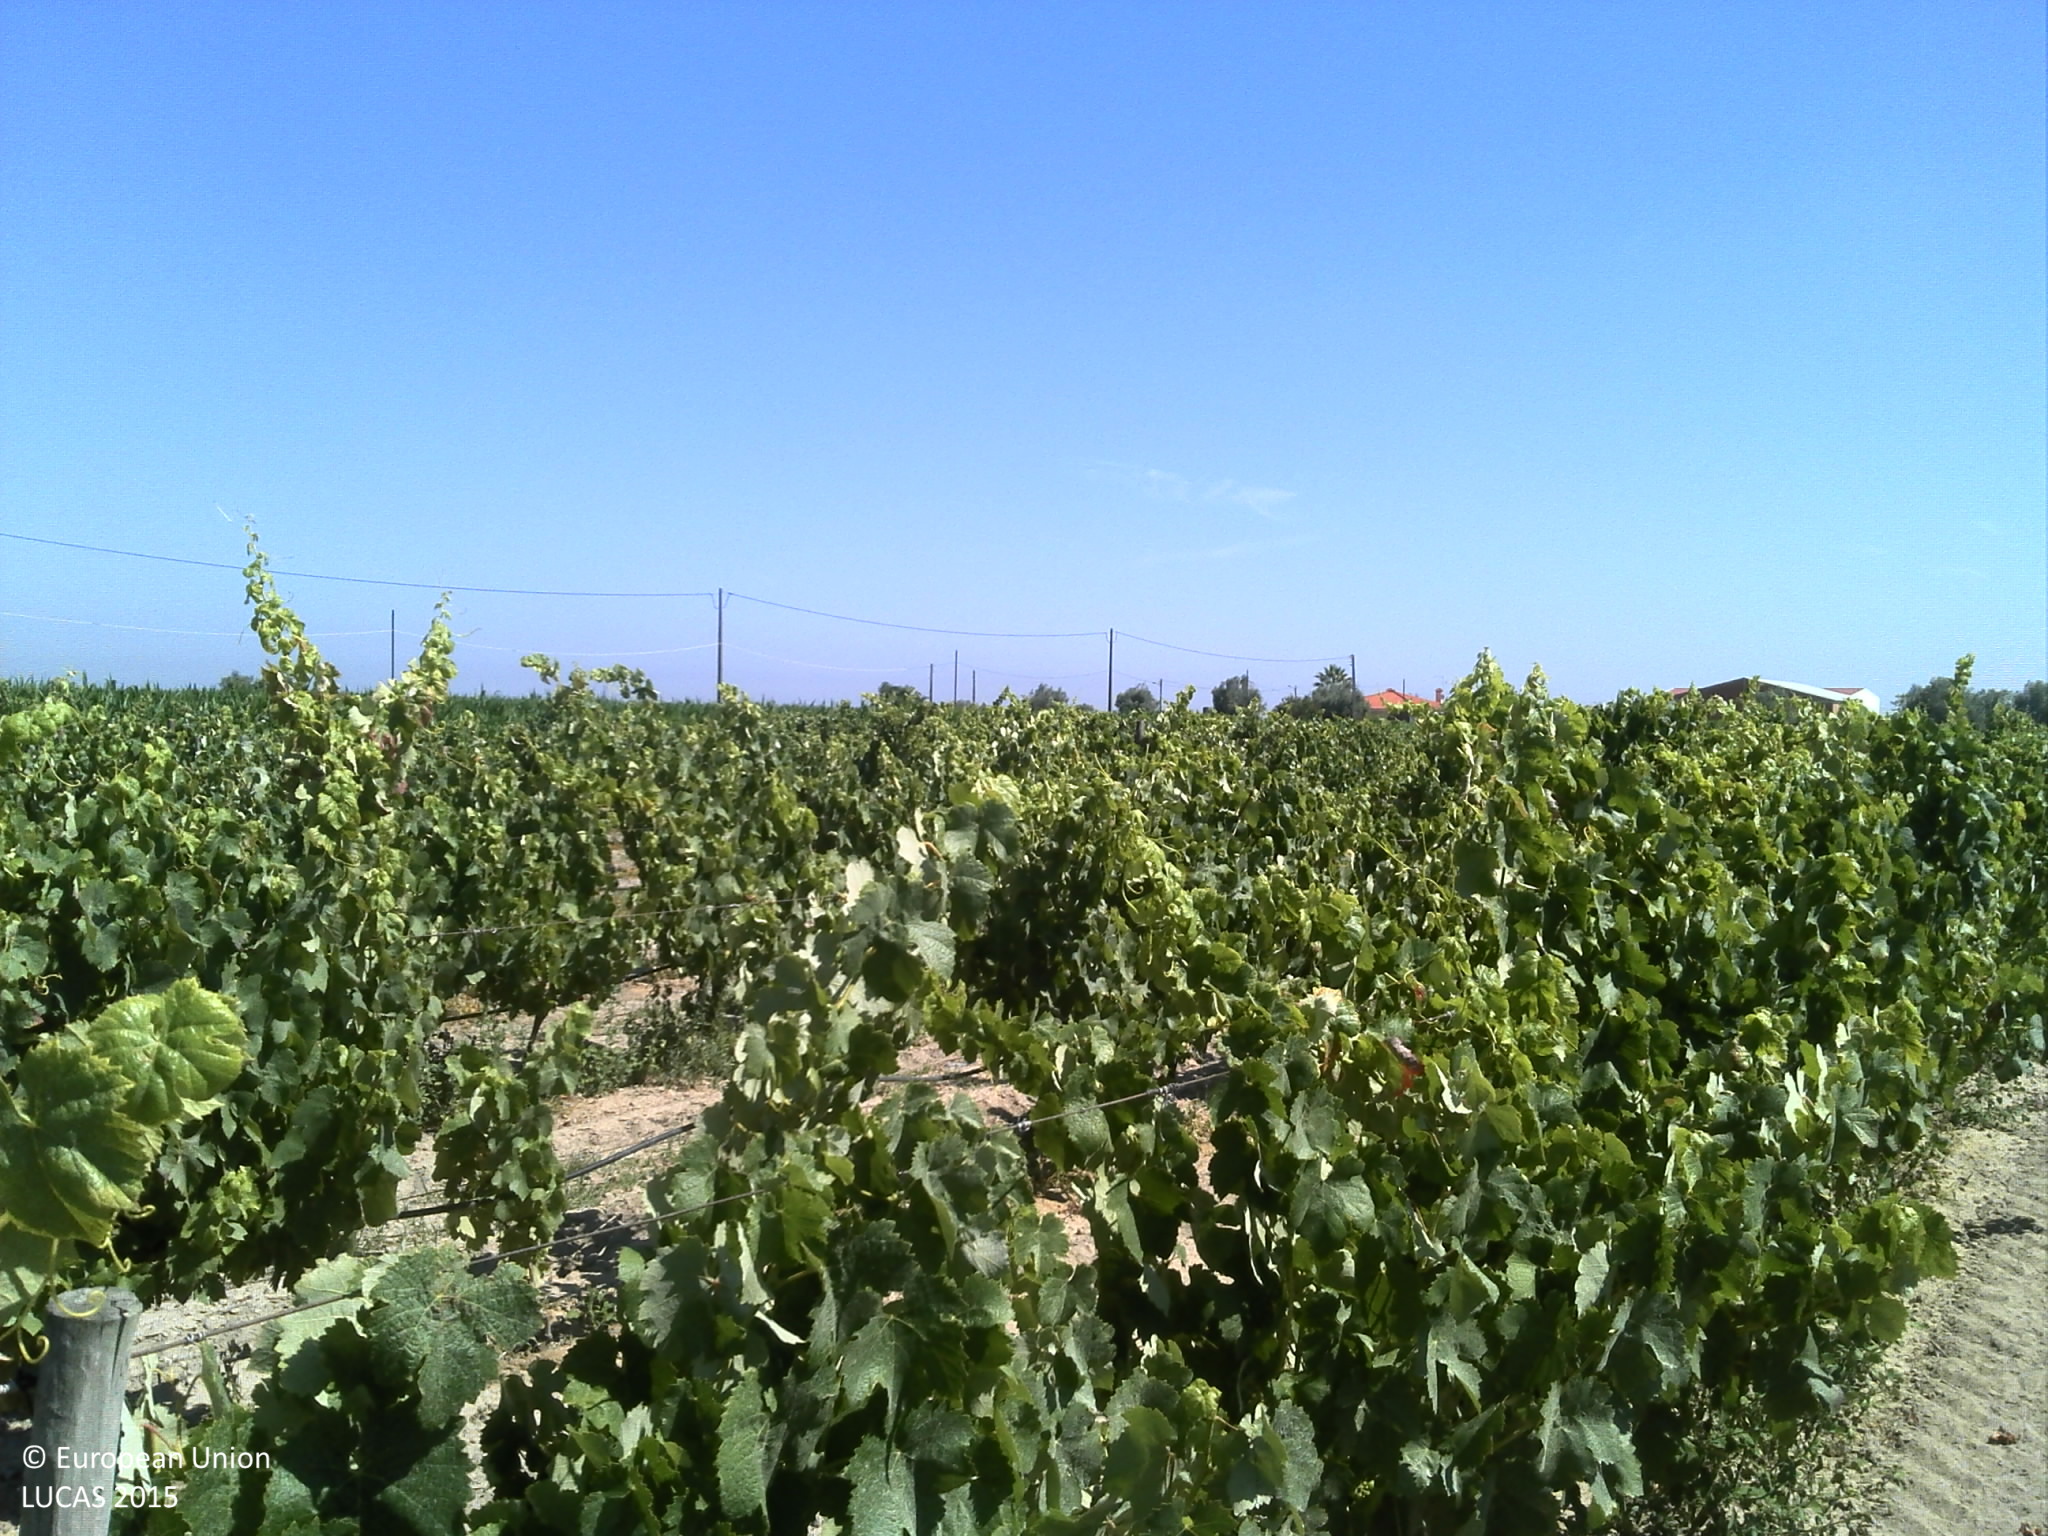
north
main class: Cropland
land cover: Vineyards
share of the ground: 25 - 50 %
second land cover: Other bare soil
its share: > 75 %
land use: Agriculture (excluding fallow land and kitchen gardens)
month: June
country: PT
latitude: 39.1258
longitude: -8.6582
